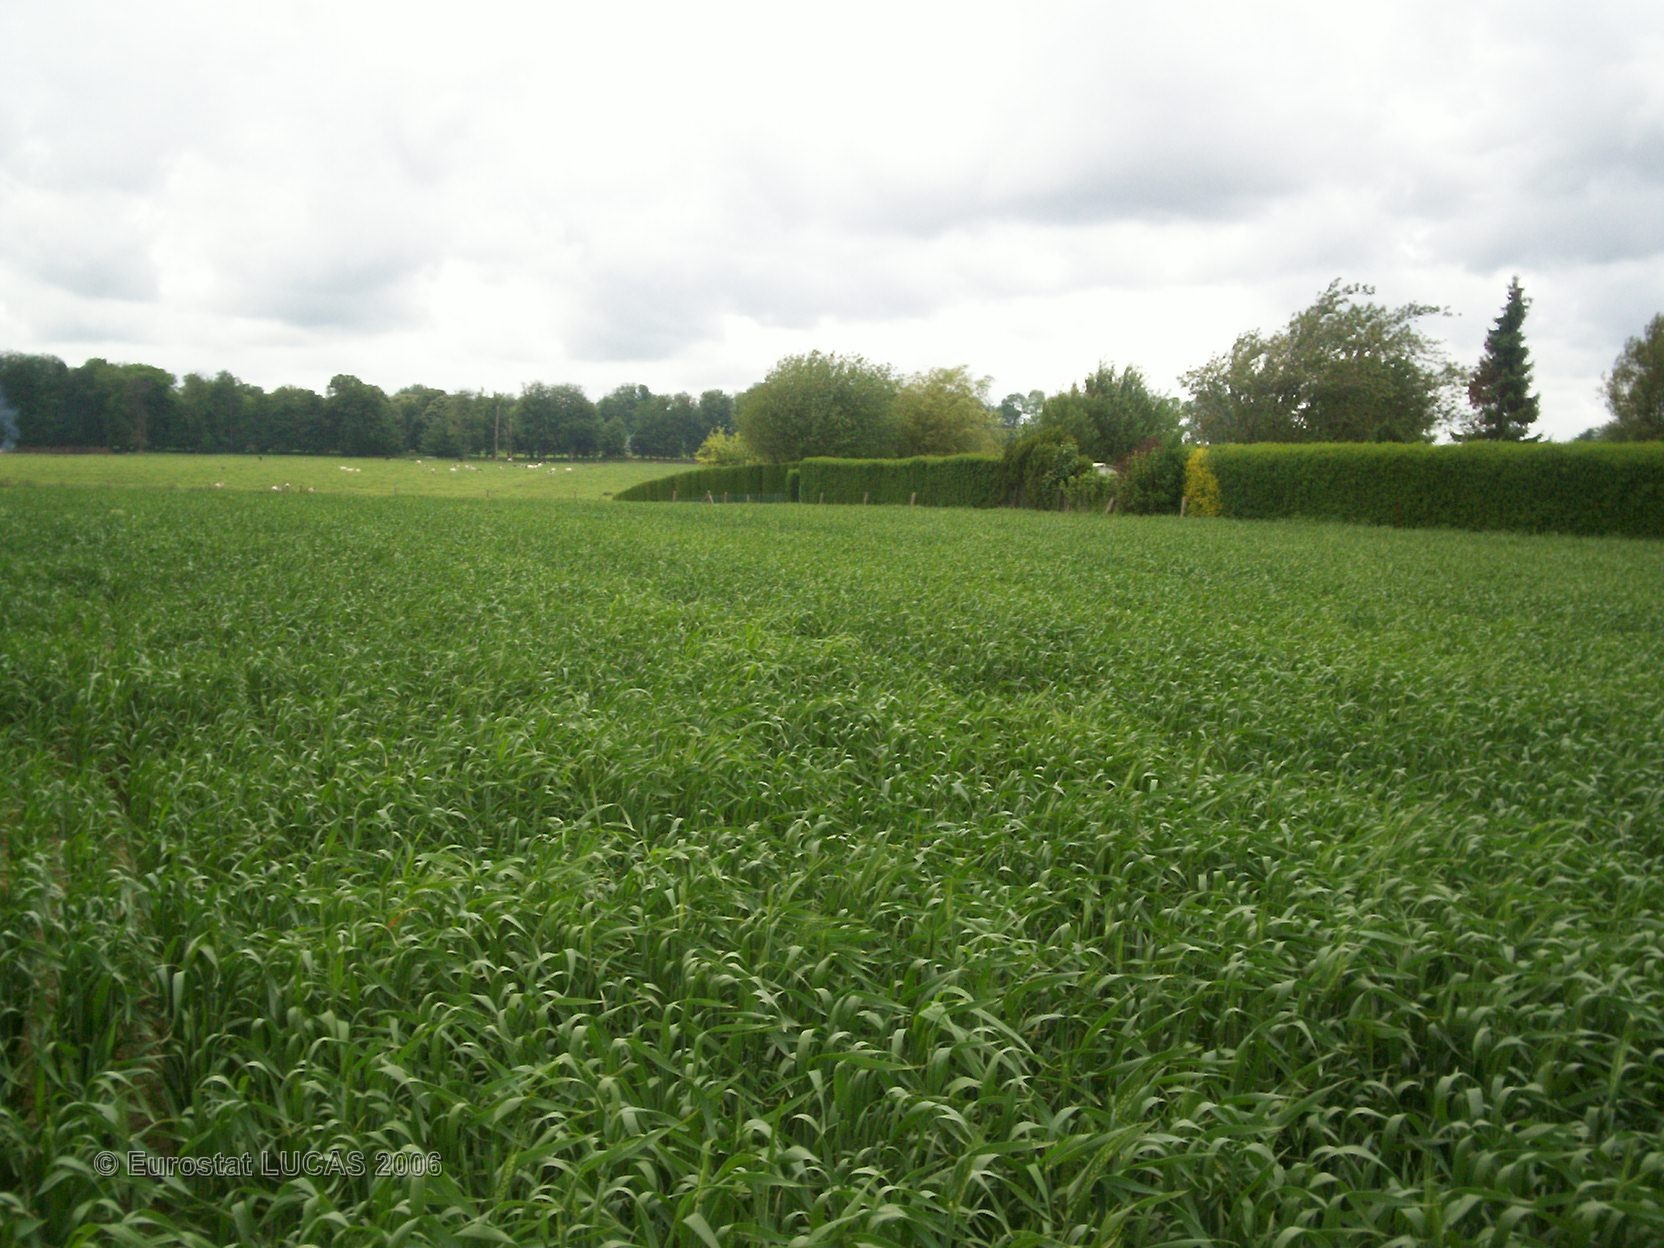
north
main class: Cropland
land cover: Common wheat
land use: Agriculture (excluding fallow land and kitchen gardens)
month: May
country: FR
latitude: 49.6338
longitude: 0.4048
